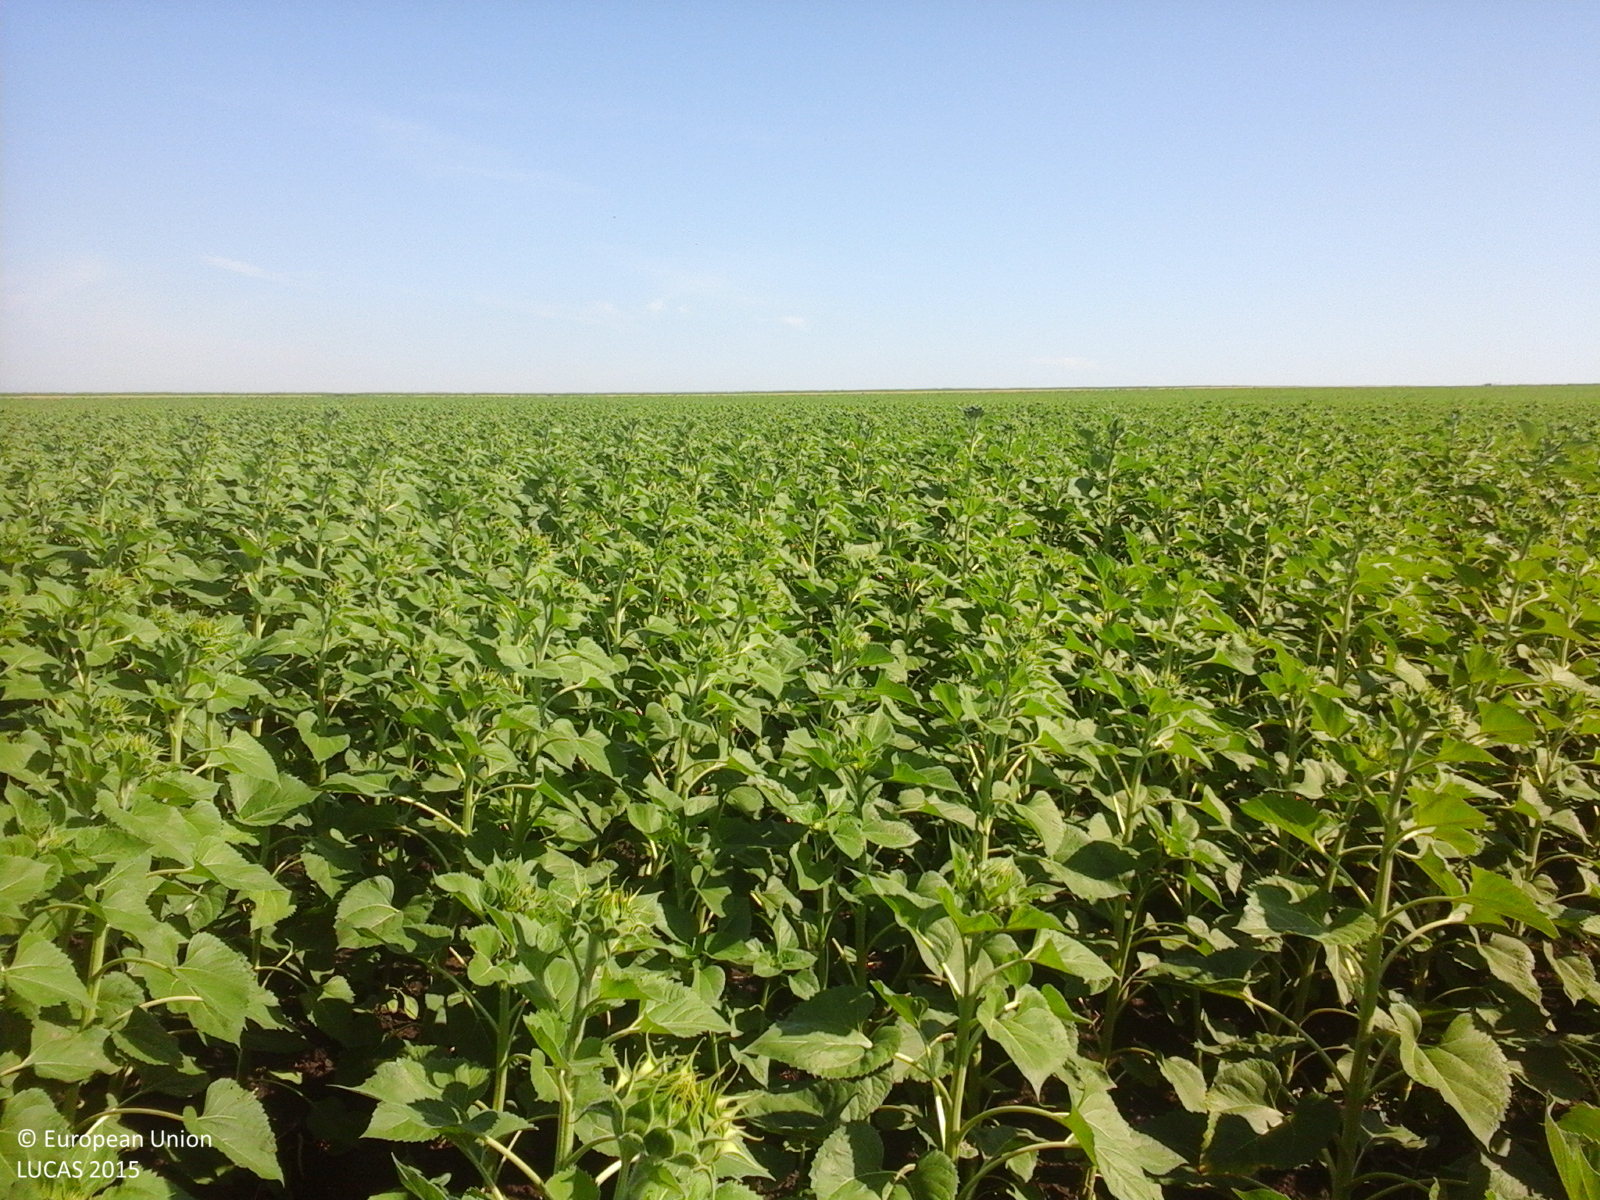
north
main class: Cropland
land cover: Sunflower
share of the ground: > 75 %
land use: Agriculture (excluding fallow land and kitchen gardens)
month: June
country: RO
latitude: 47.7235
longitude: 27.0783
